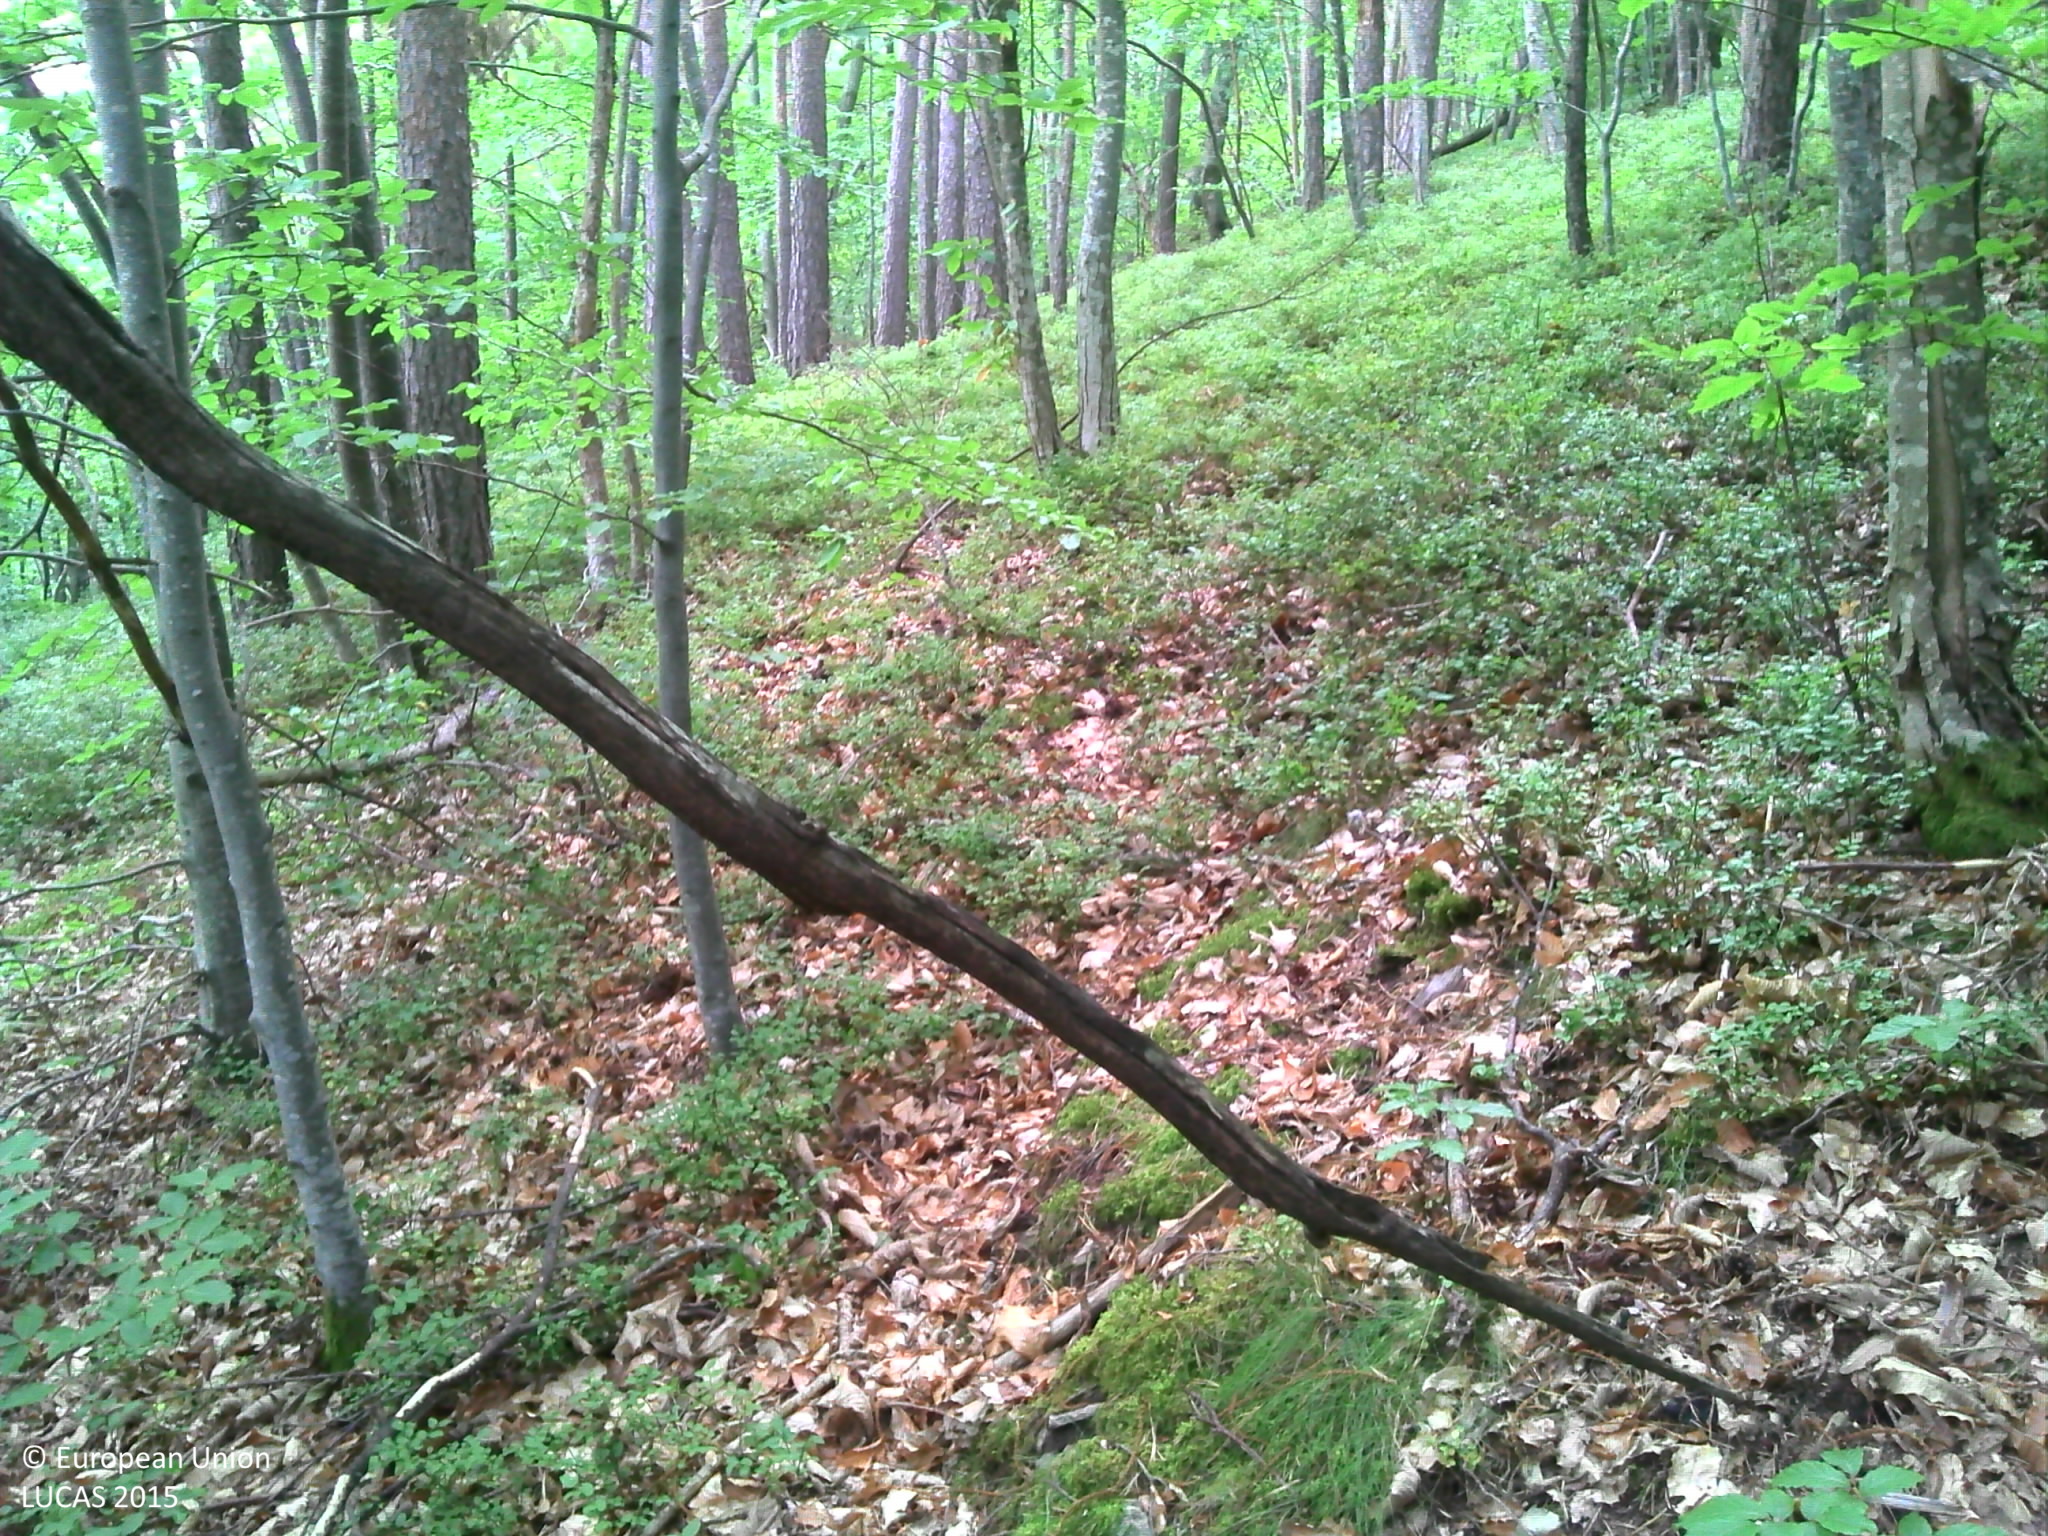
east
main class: Woodland
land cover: Pine dominated mixed woodland
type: mountainous beech forest
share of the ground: > 75 %
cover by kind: broadleaved forest trees 50 %, coniferous forest trees 25 %, unconsolidated bare surface 15 %, shrubs 5 %, herbaceous plants 5 %
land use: Forestry
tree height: > 5 m
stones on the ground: < 10 %
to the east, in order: Pine dominated mixed woodland
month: August
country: FR
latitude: 45.0390
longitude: 4.5592
